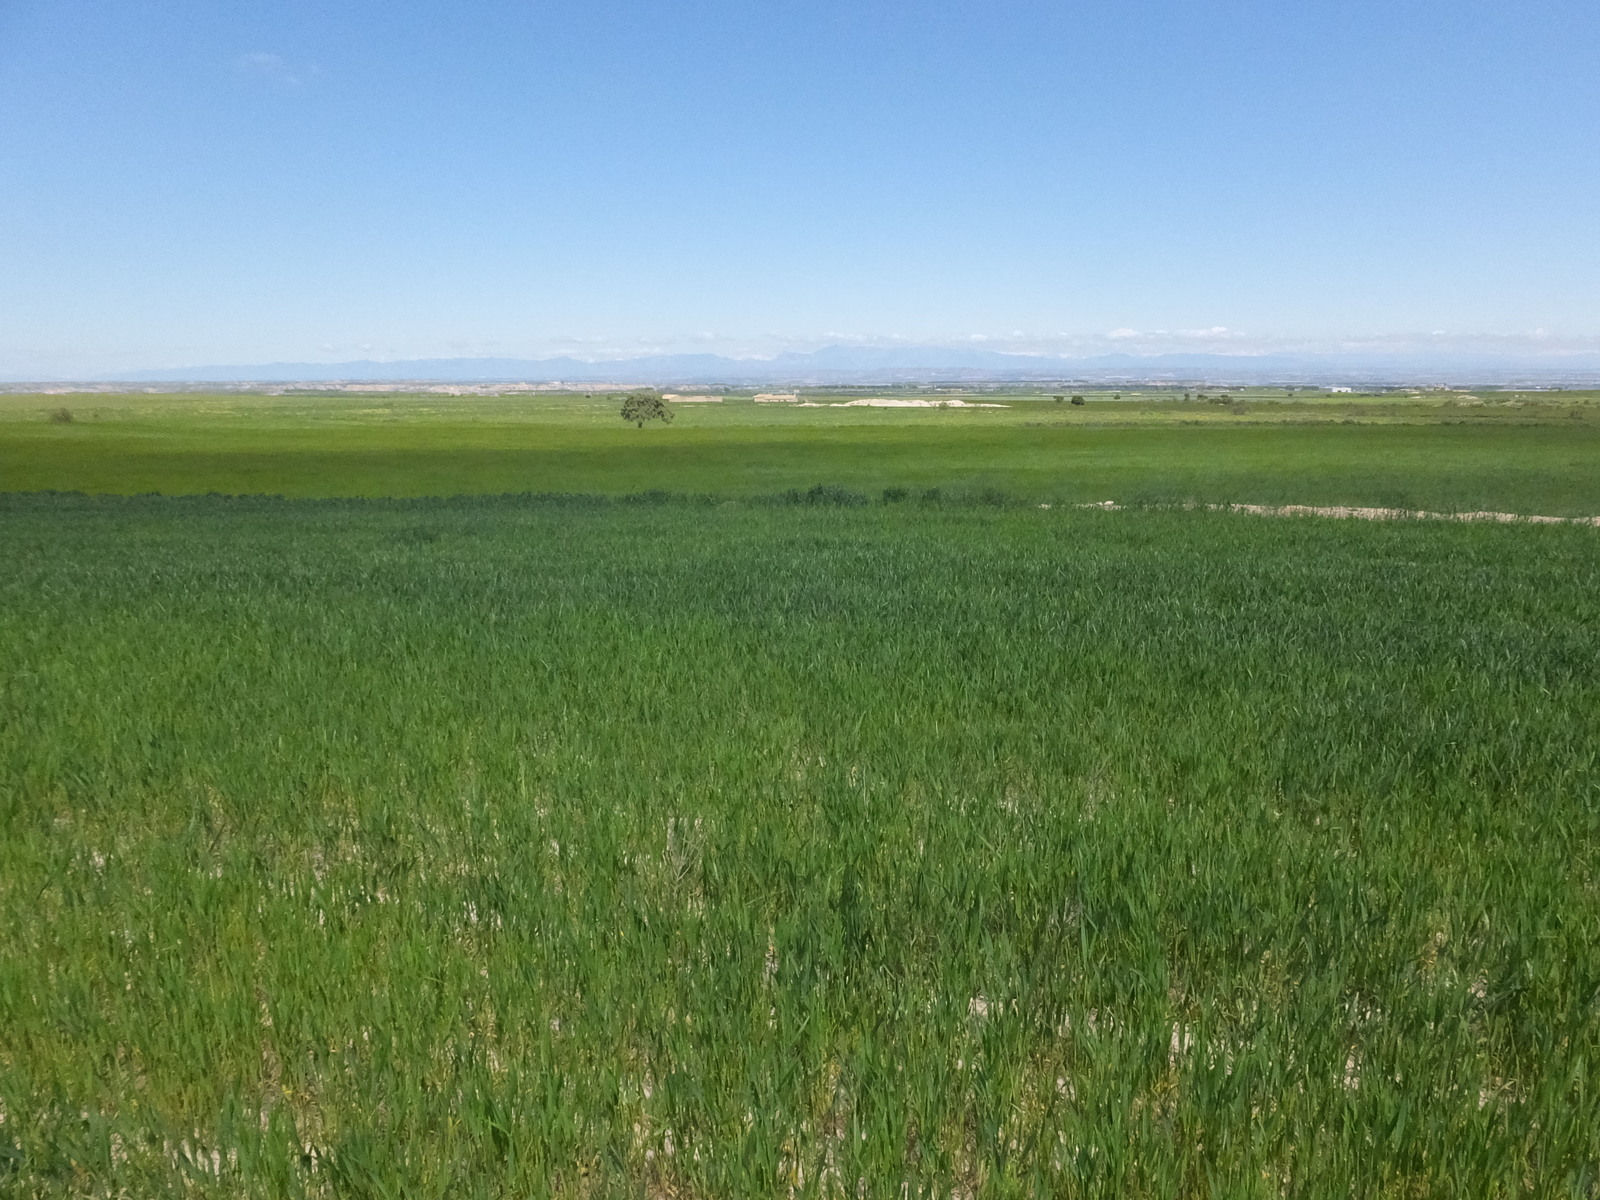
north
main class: Cropland
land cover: Barley
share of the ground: > 75 %
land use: Agriculture (excluding fallow land and kitchen gardens)
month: April
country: ES
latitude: 41.7072
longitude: -0.3176
